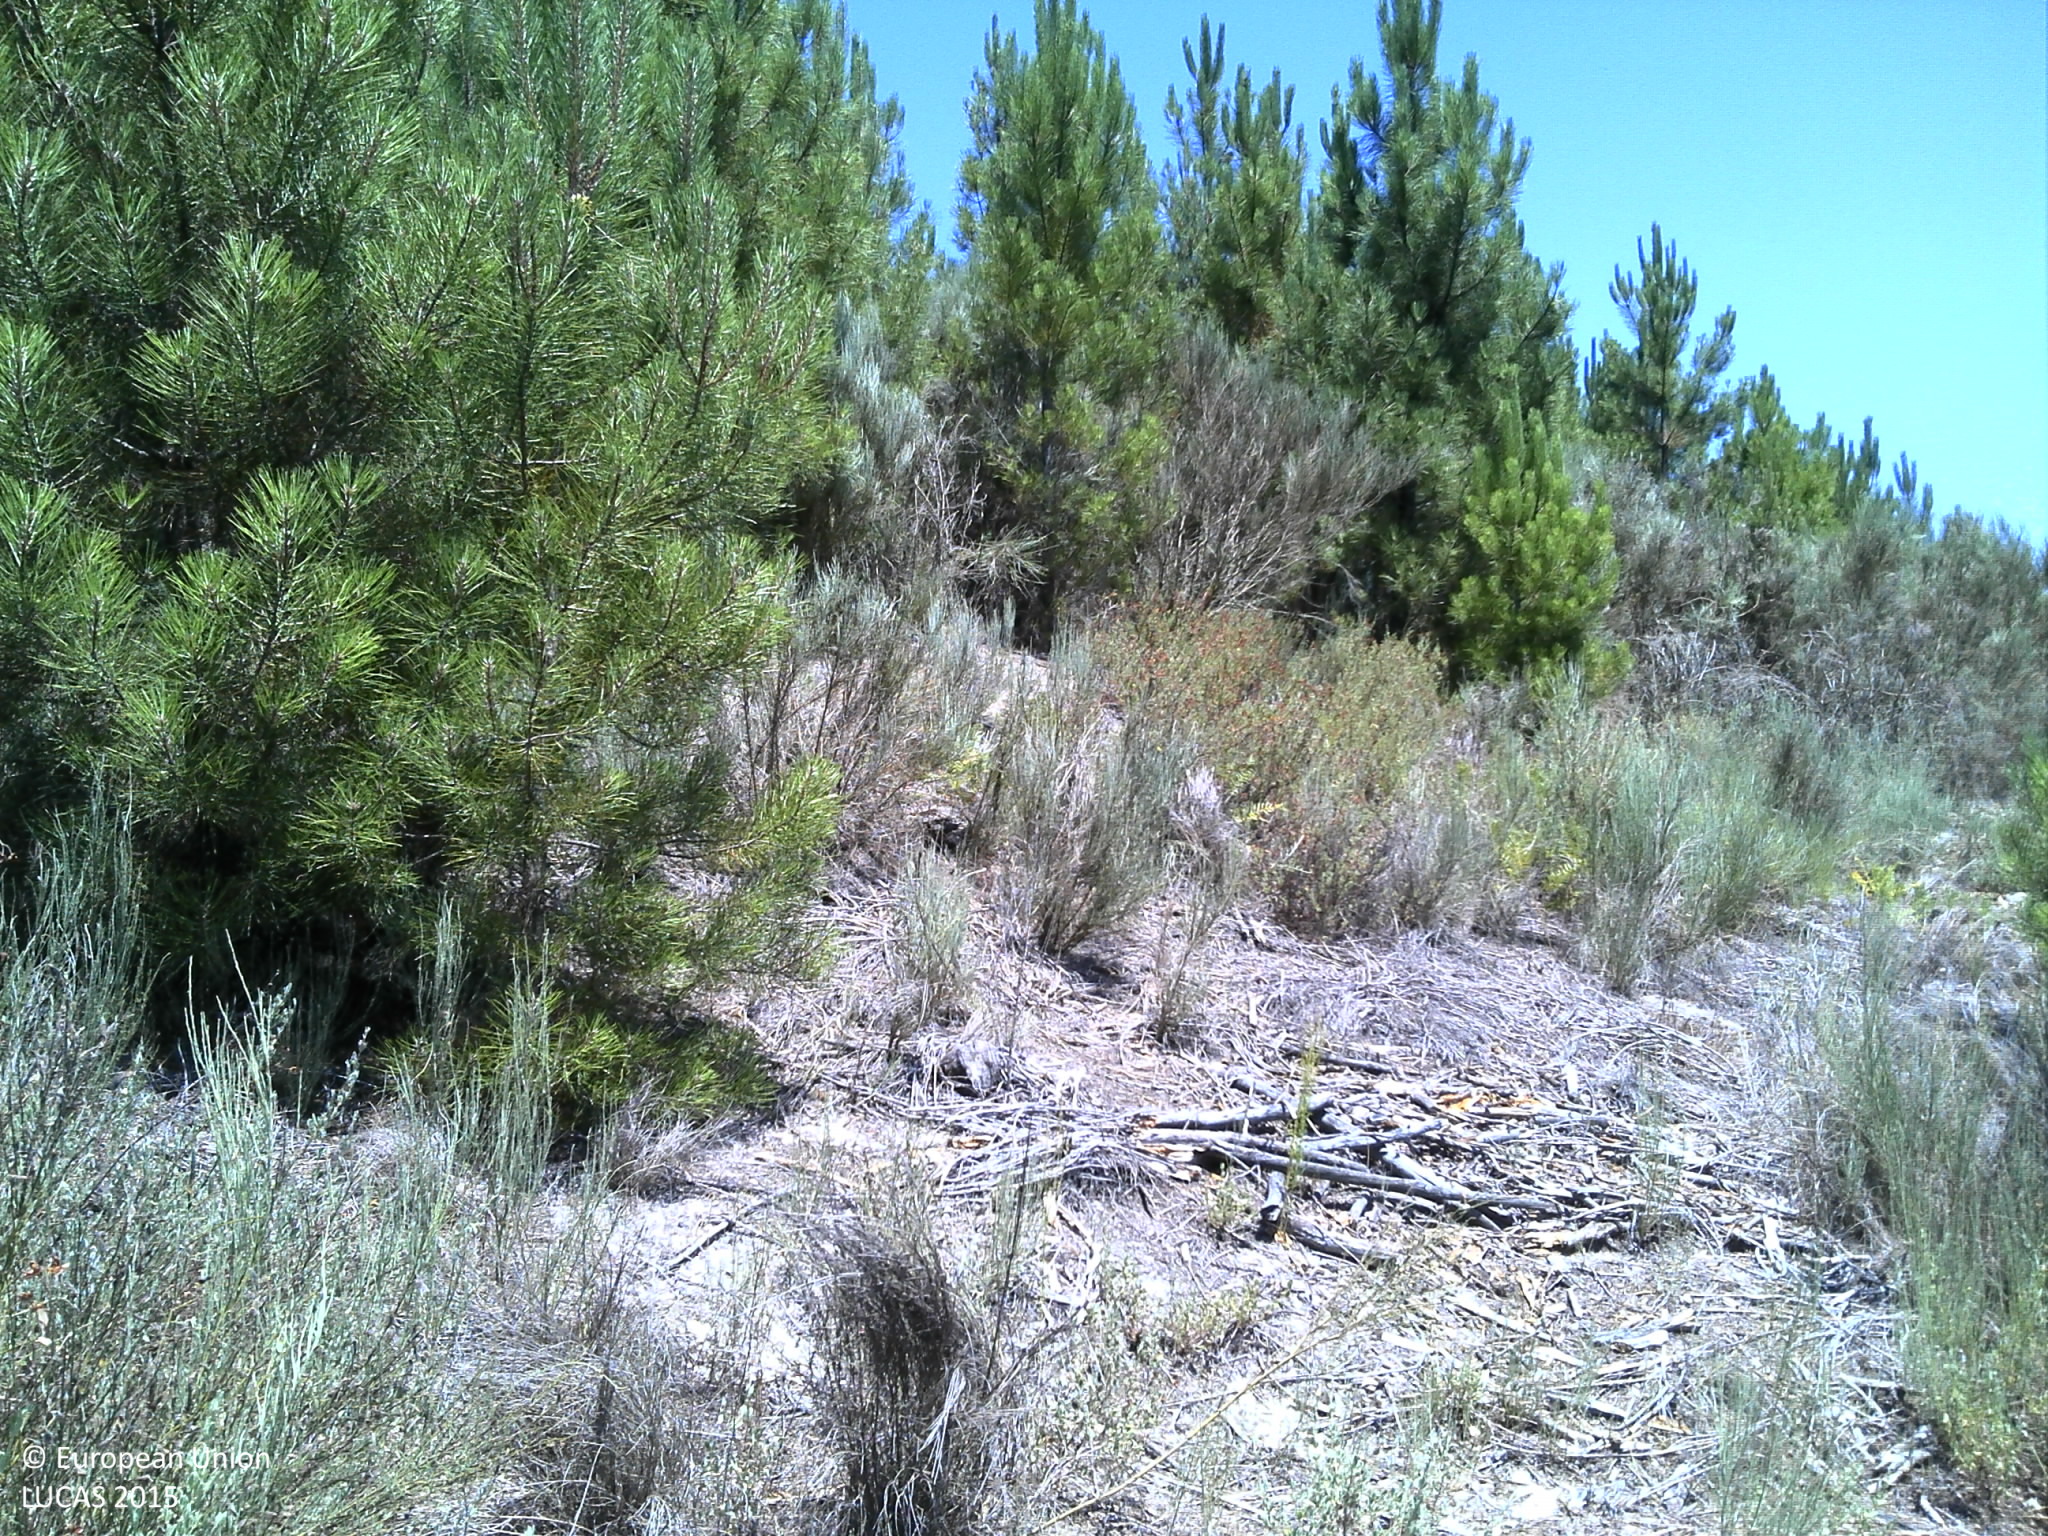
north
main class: Woodland
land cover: Pine dominated coniferous woodland
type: coniferous forest of the mediterranean region
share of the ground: 10 - 25 %
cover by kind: shrubs 80 %, coniferous forest trees 15 %, consolidated bare surface 5 %
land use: Forestry
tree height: < 5 m
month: July
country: PT
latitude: 40.7720
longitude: -7.5690
